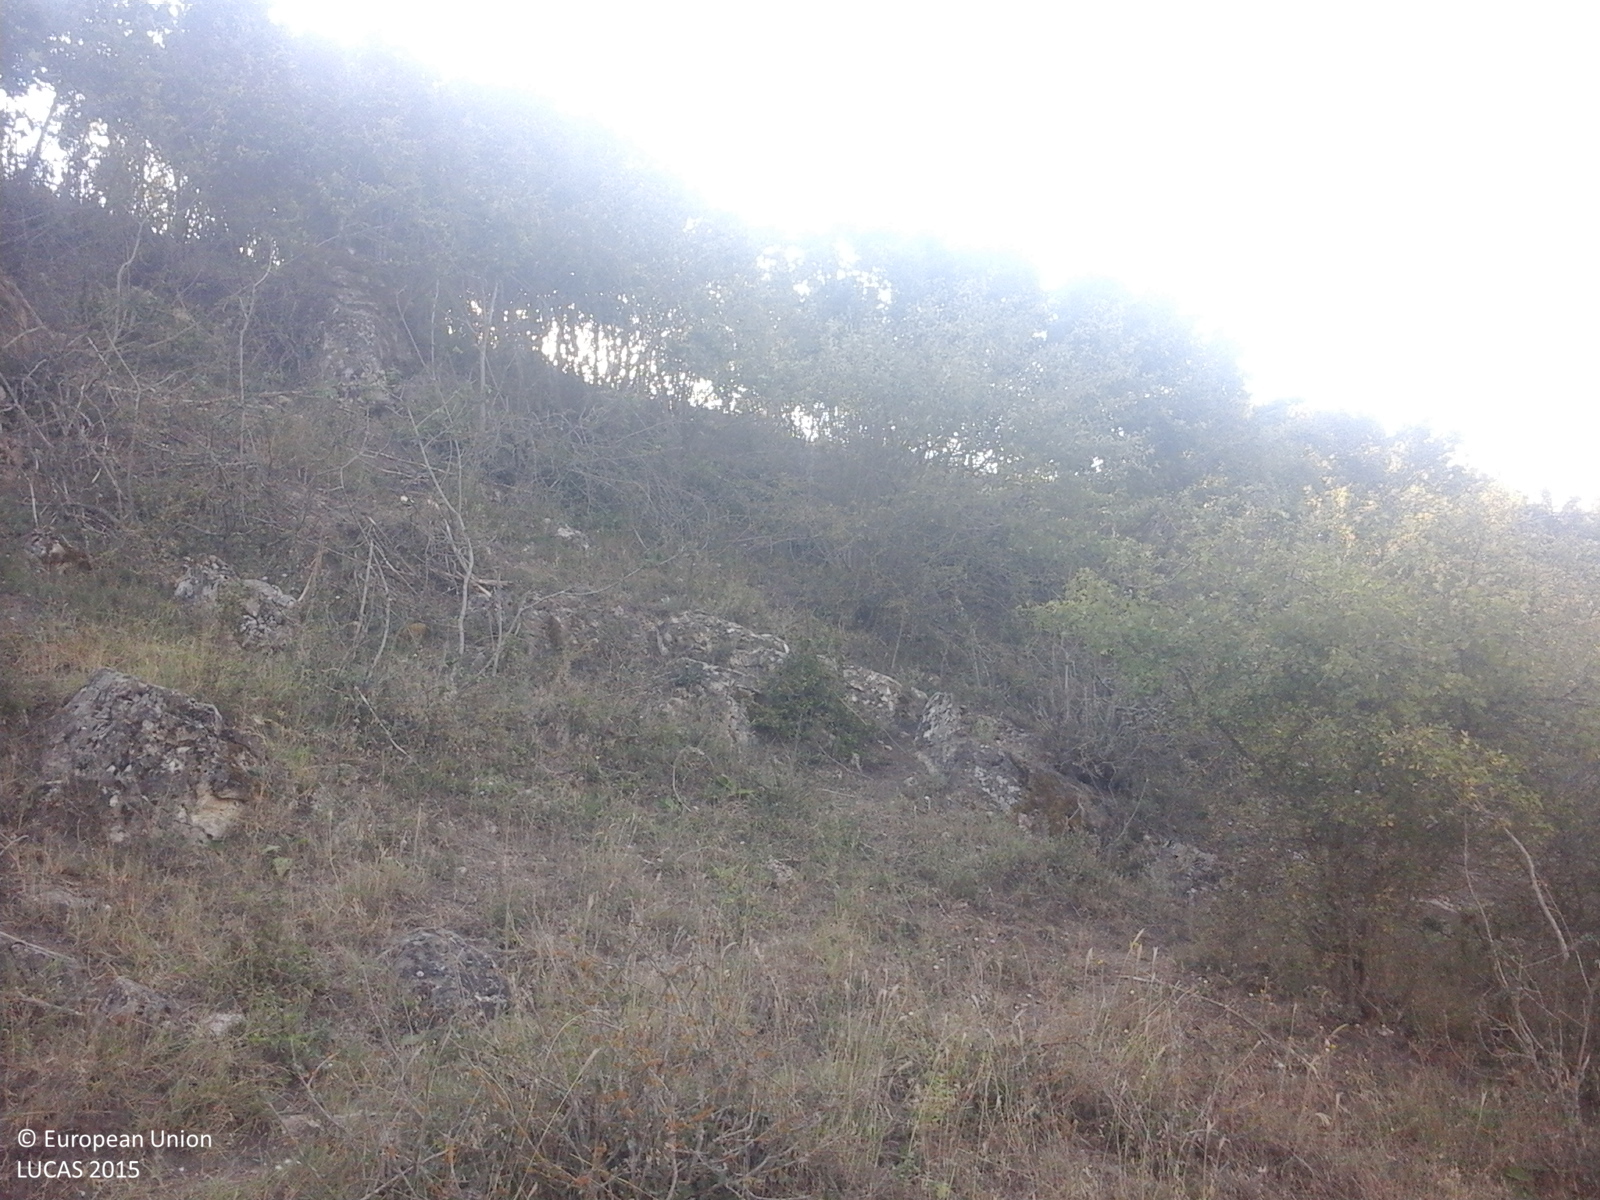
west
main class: Grassland
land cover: Grassland with sparse tree/shrub cover
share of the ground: > 75 %
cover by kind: herbaceous plants 95 %, broadleaved forest trees 5 %
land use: Semi-natural and natural areas not in use
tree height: < 5 m
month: August
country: RO
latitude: 44.1191
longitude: 28.0361
